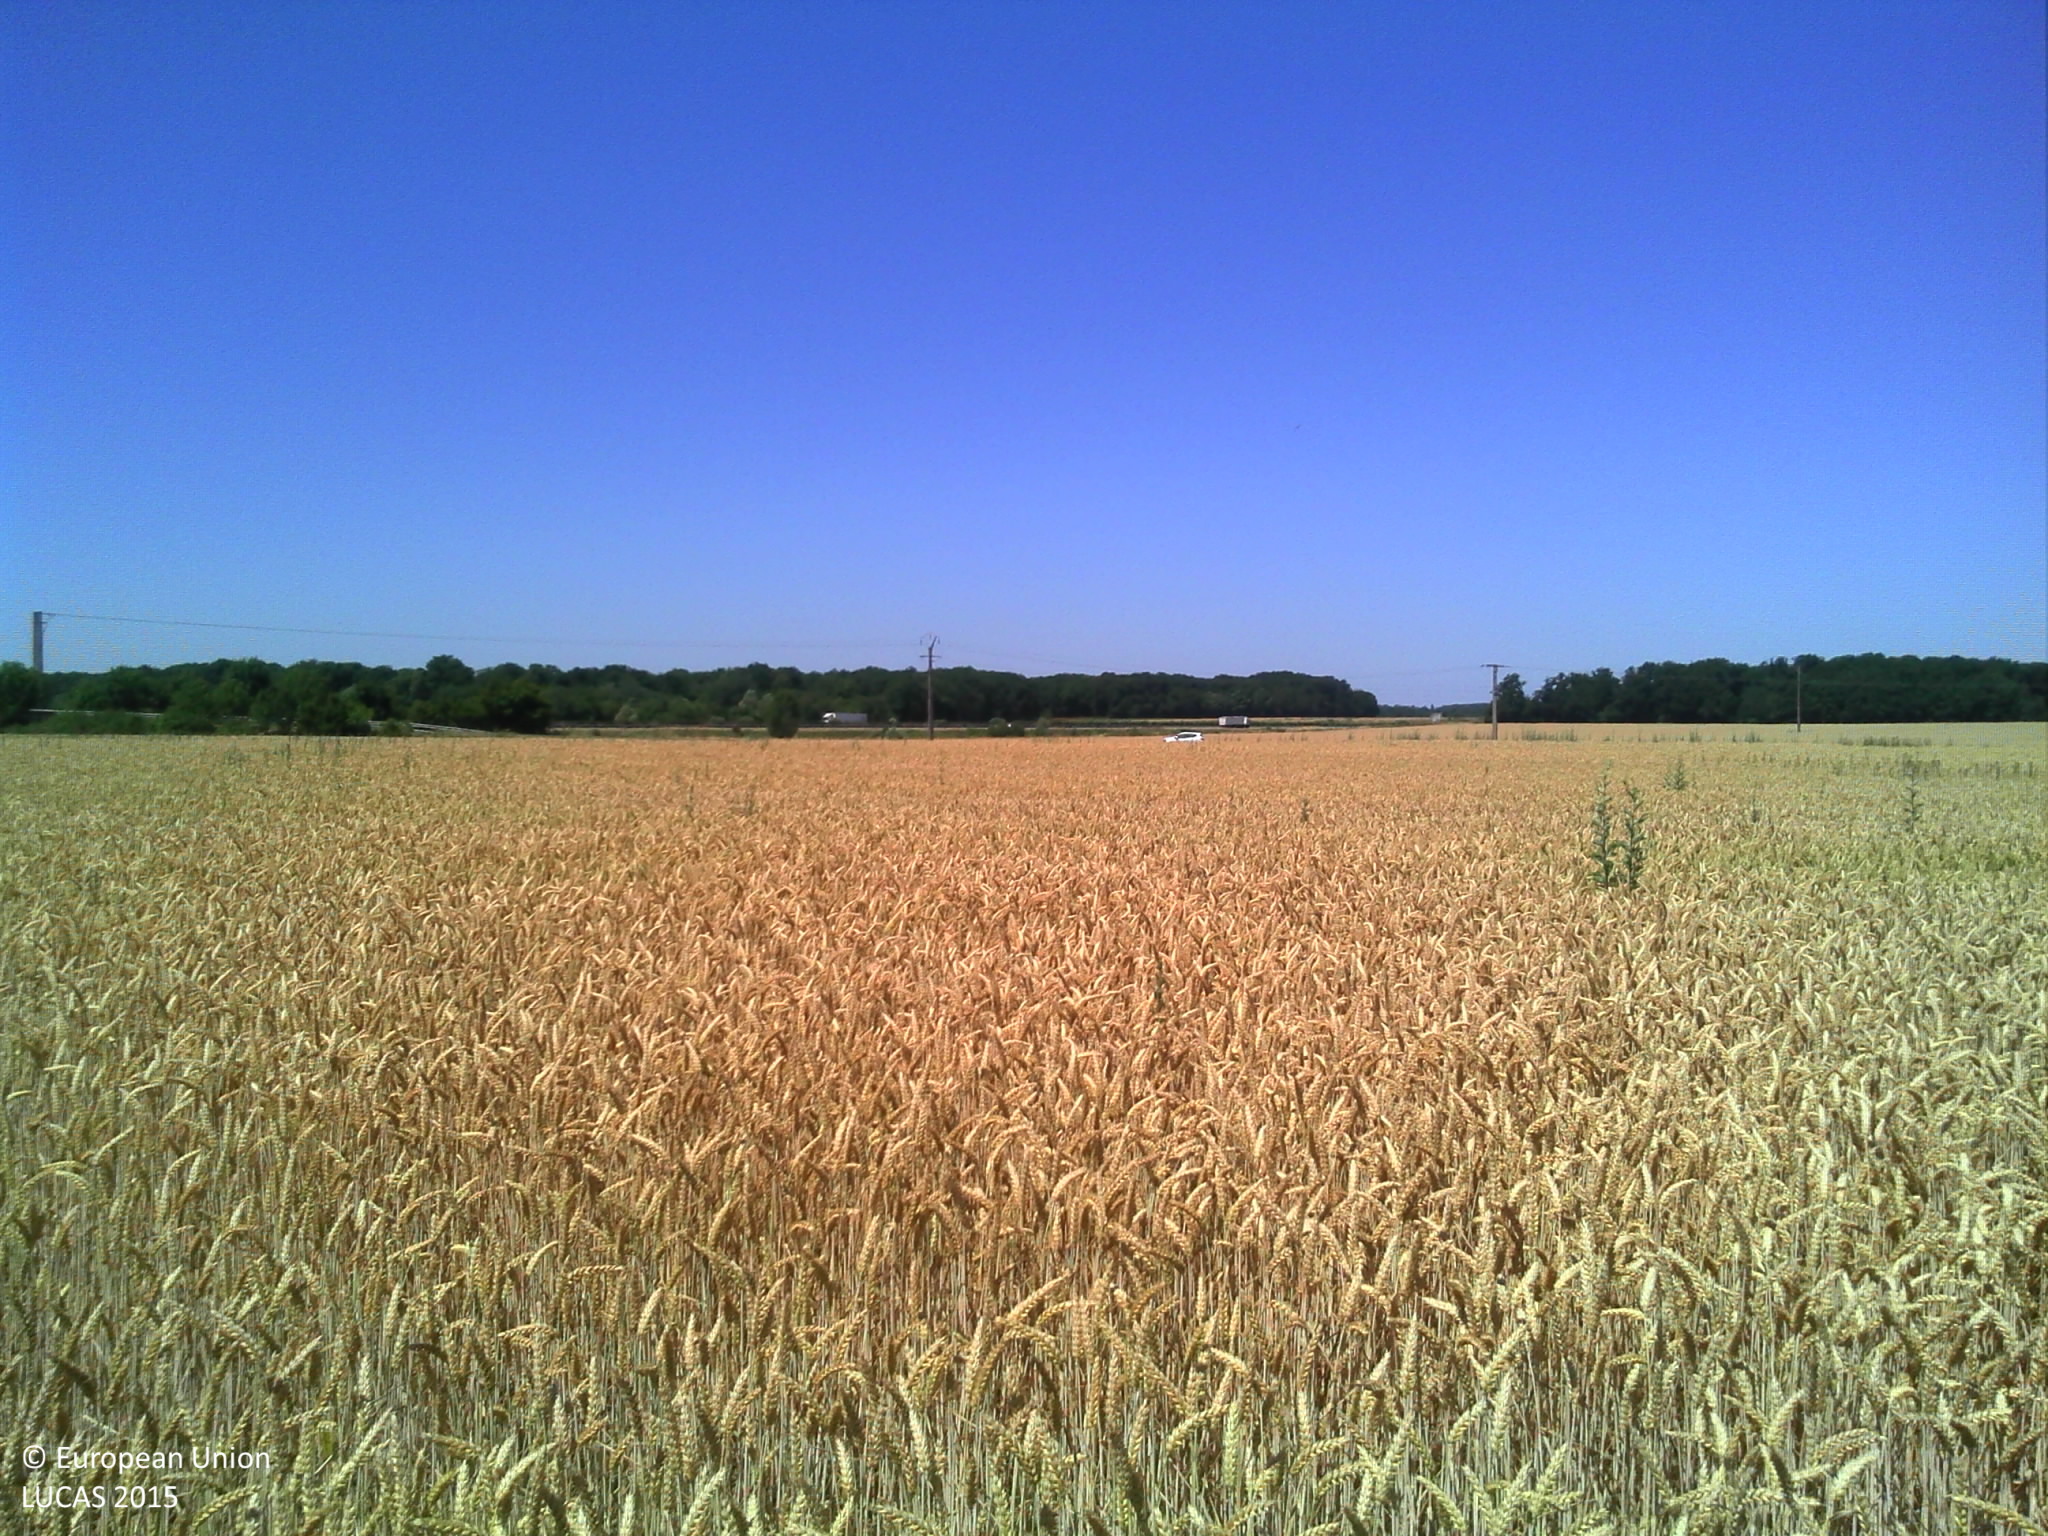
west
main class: Cropland
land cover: Common wheat
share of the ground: > 75 %
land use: Agriculture (excluding fallow land and kitchen gardens)
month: June
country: FR
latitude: 47.5939
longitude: 2.8519
